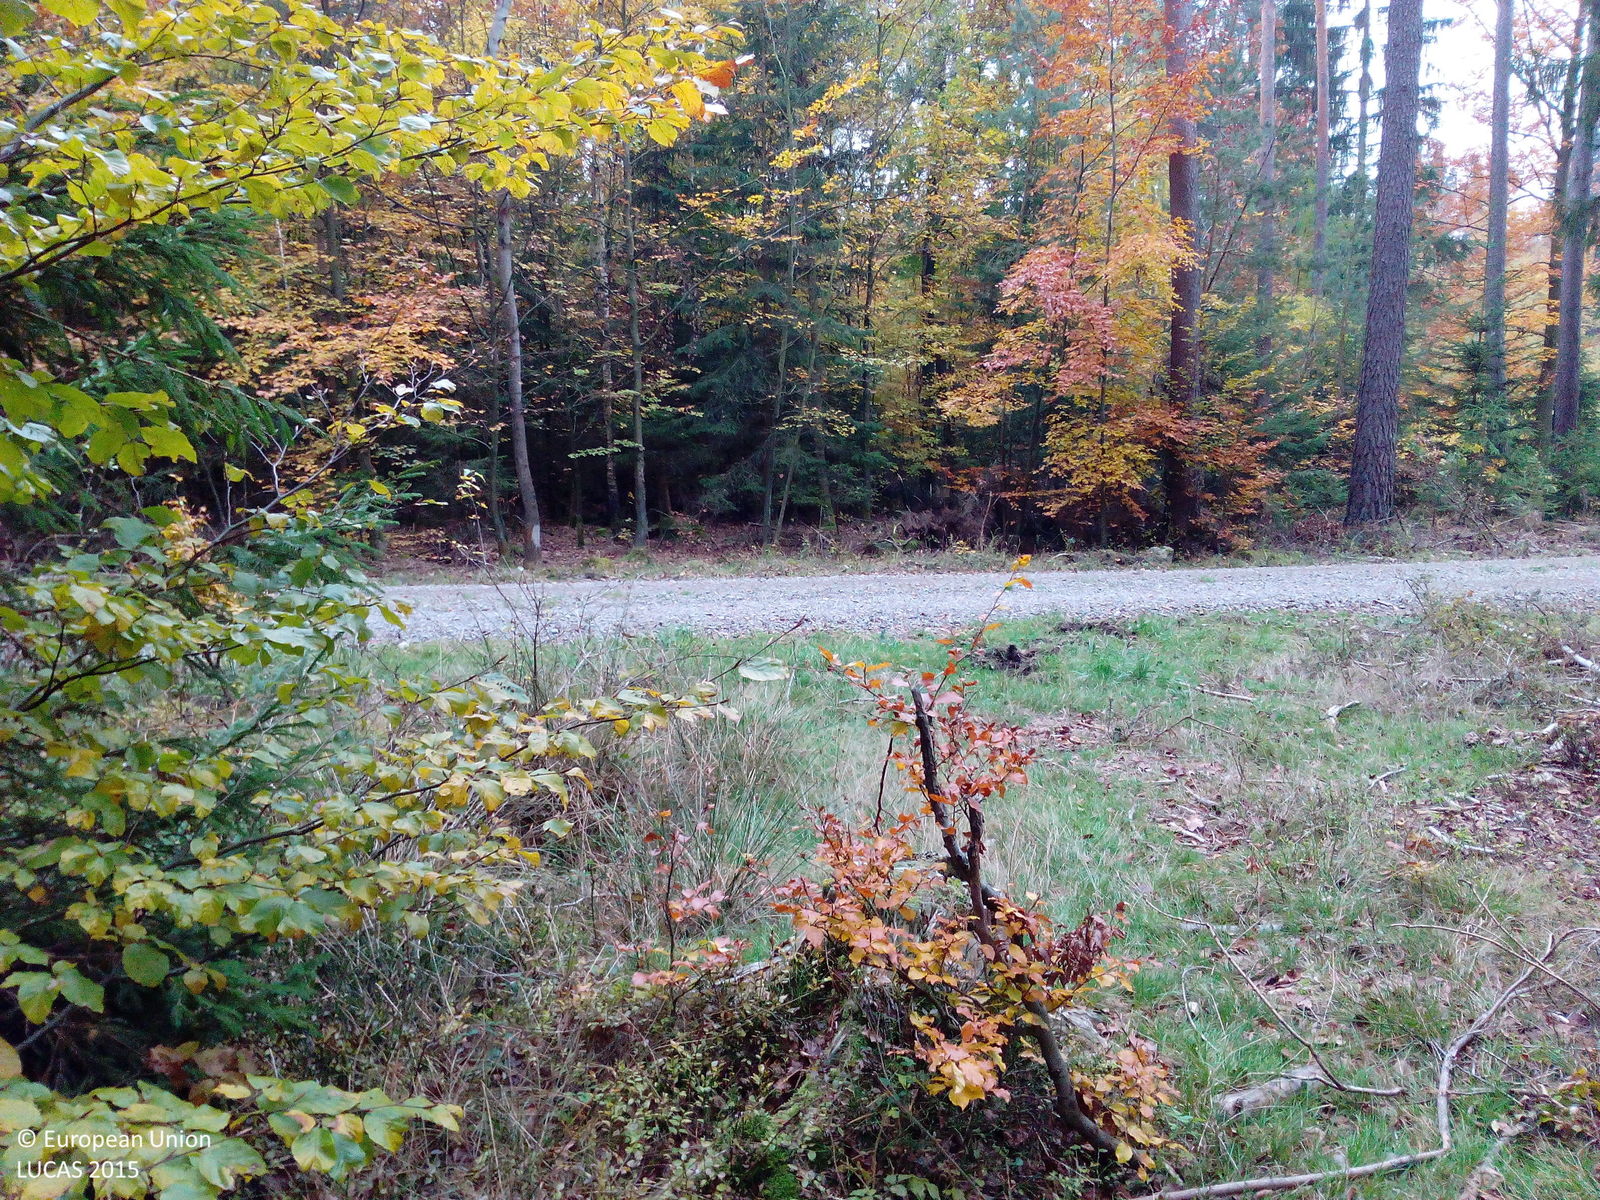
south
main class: Woodland
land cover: Other mixed woodland
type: hemiboreal forest and nemoral coniferous forest and mixed broadleaved-coniferous forest
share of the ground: > 75 %
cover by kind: coniferous forest trees 50 %, broadleaved forest trees 30 %, shrubs 10 %, unconsolidated bare surface 10 %
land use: Forestry
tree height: > 5 m
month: October
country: DE
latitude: 50.2022
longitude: 9.9020
